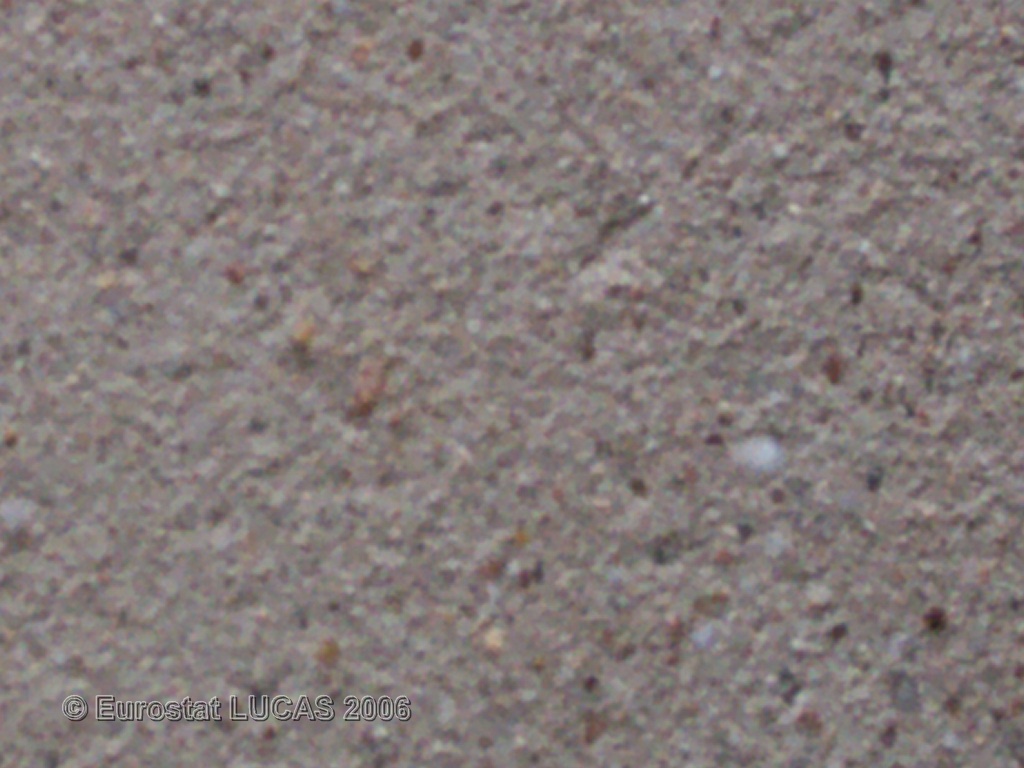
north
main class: Grassland
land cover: Grassland with sparse tree/shrub cover
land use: Residential
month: April
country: FR
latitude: 48.6711
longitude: 7.0811
